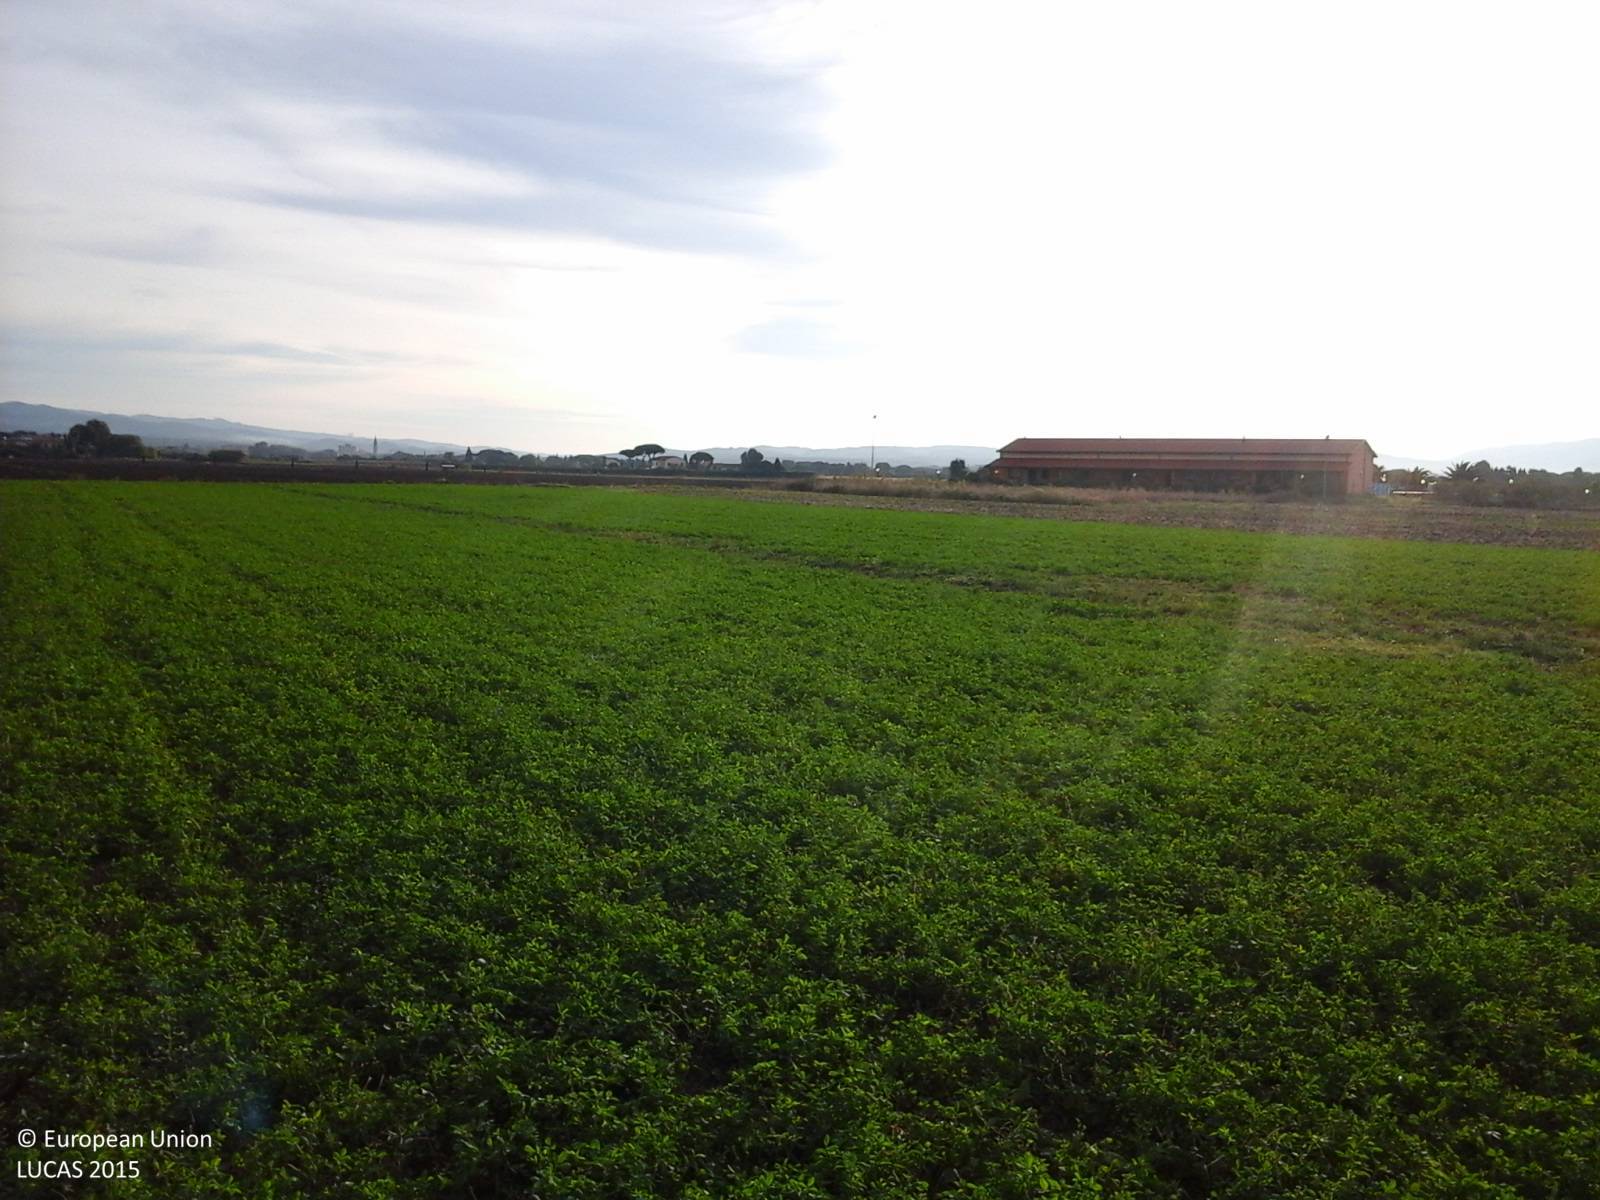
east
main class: Cropland
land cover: Lucerne
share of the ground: > 75 %
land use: Agriculture (excluding fallow land and kitchen gardens)
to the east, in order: Lucerne; Ditches and canals; Lucerne; Ditches and canals; Grass margins; Common wheat; Ditches and canals; Shruby margins; Ditches and canals; Tomatoes; Ditches and canals; Tomatoes
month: October
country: IT
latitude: 43.3210
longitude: 10.4795
